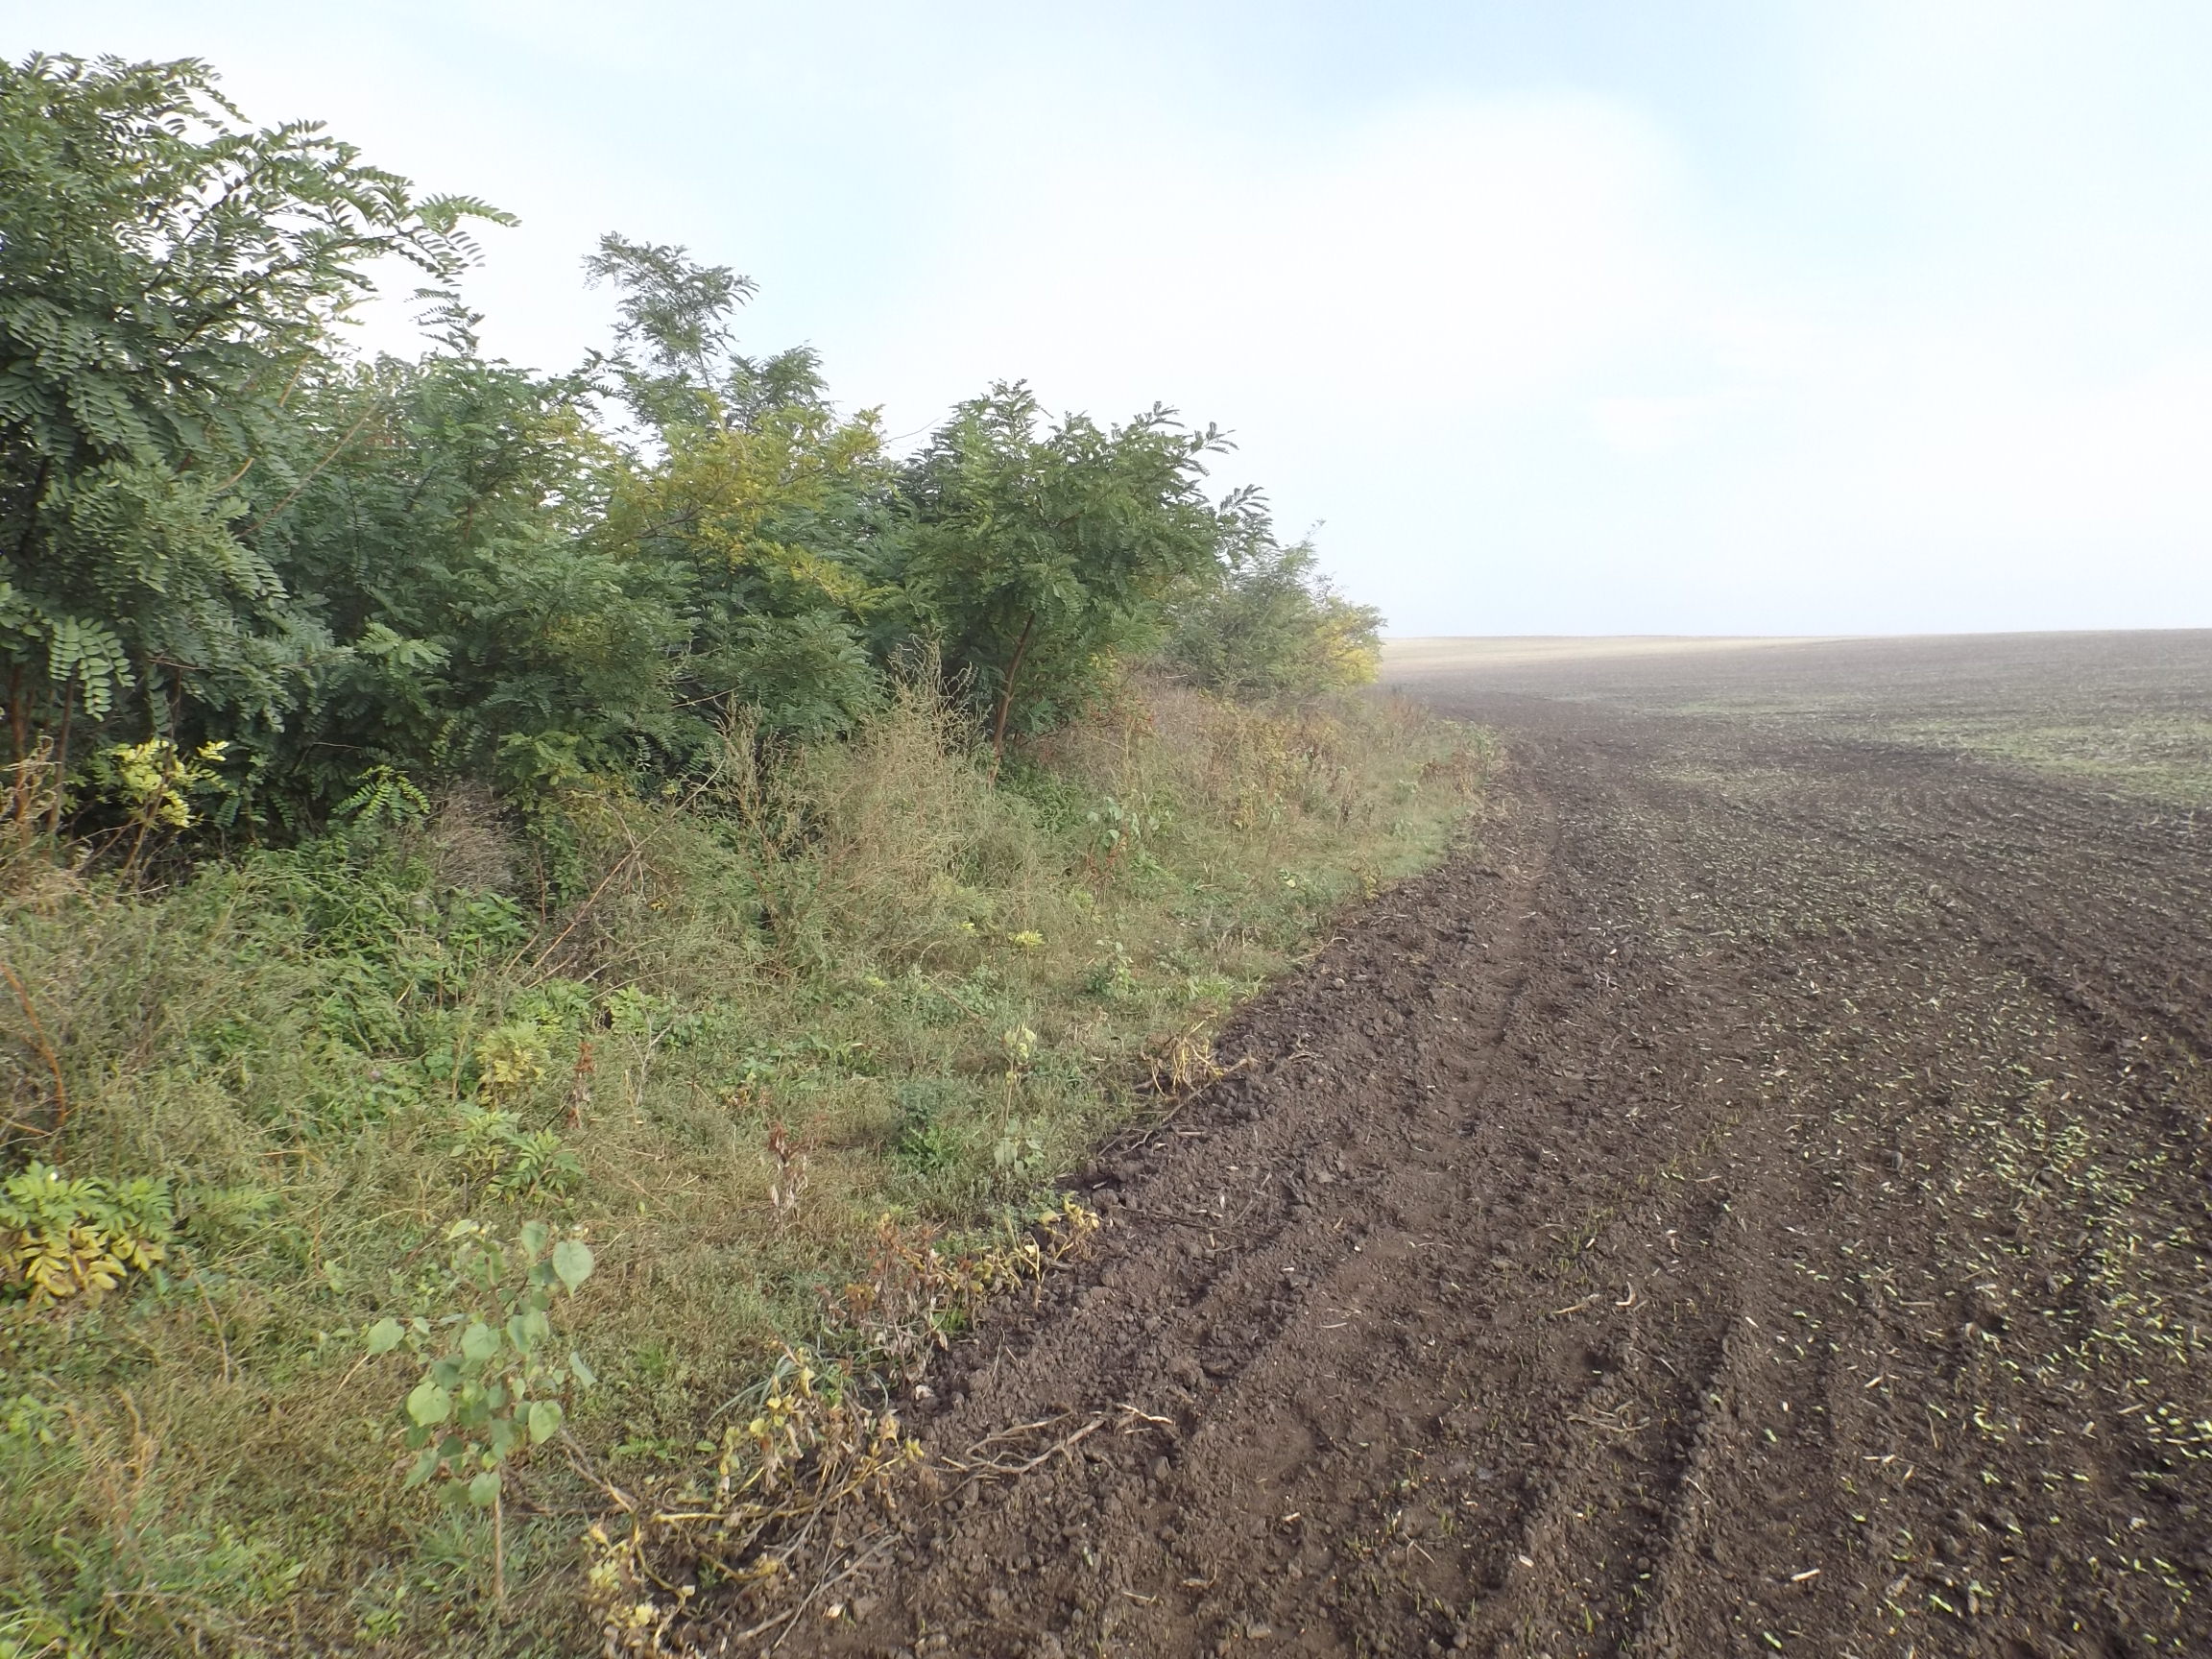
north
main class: Cropland
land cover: Sunflower
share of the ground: < 10 %
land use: Agriculture (excluding fallow land and kitchen gardens)
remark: Harvested field
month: October
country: BG
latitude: 43.1639
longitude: 27.2784
